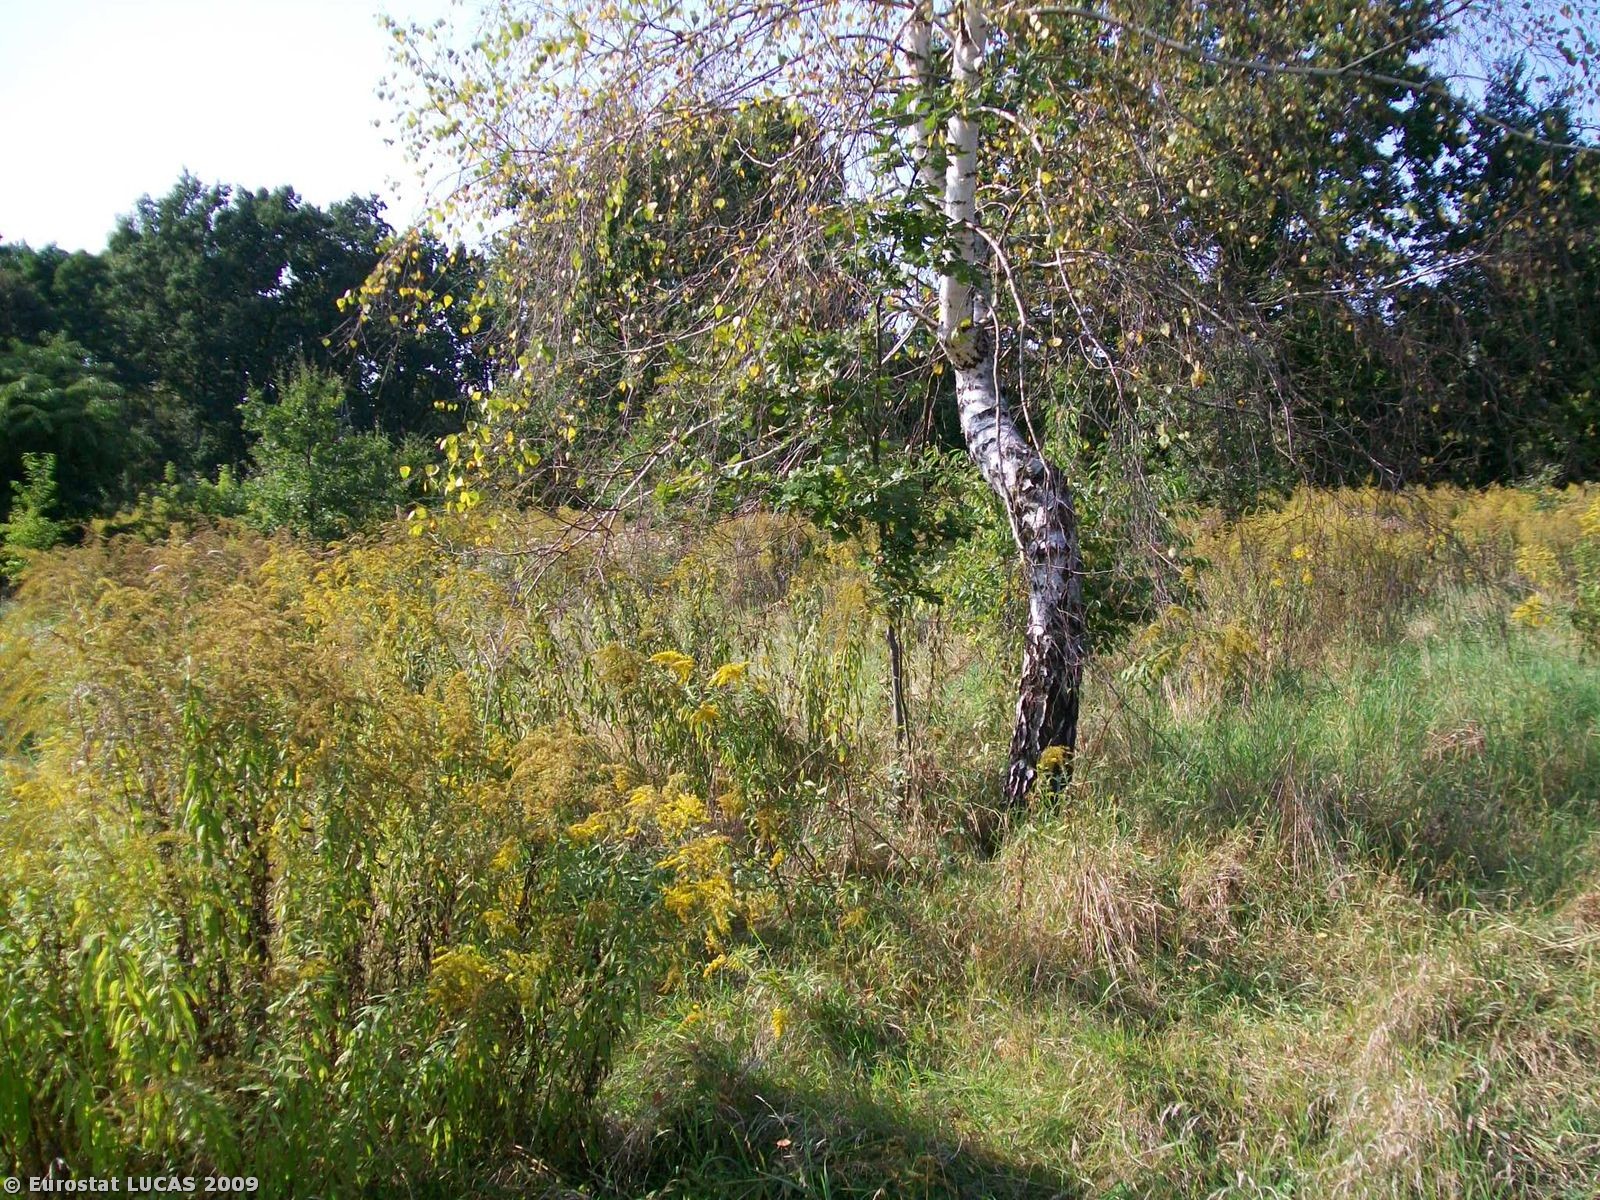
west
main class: Grassland
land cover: Spontaneously vegetated surfaces
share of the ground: > 75 %
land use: Unused
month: September
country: PL
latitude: 52.1291
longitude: 20.6897
